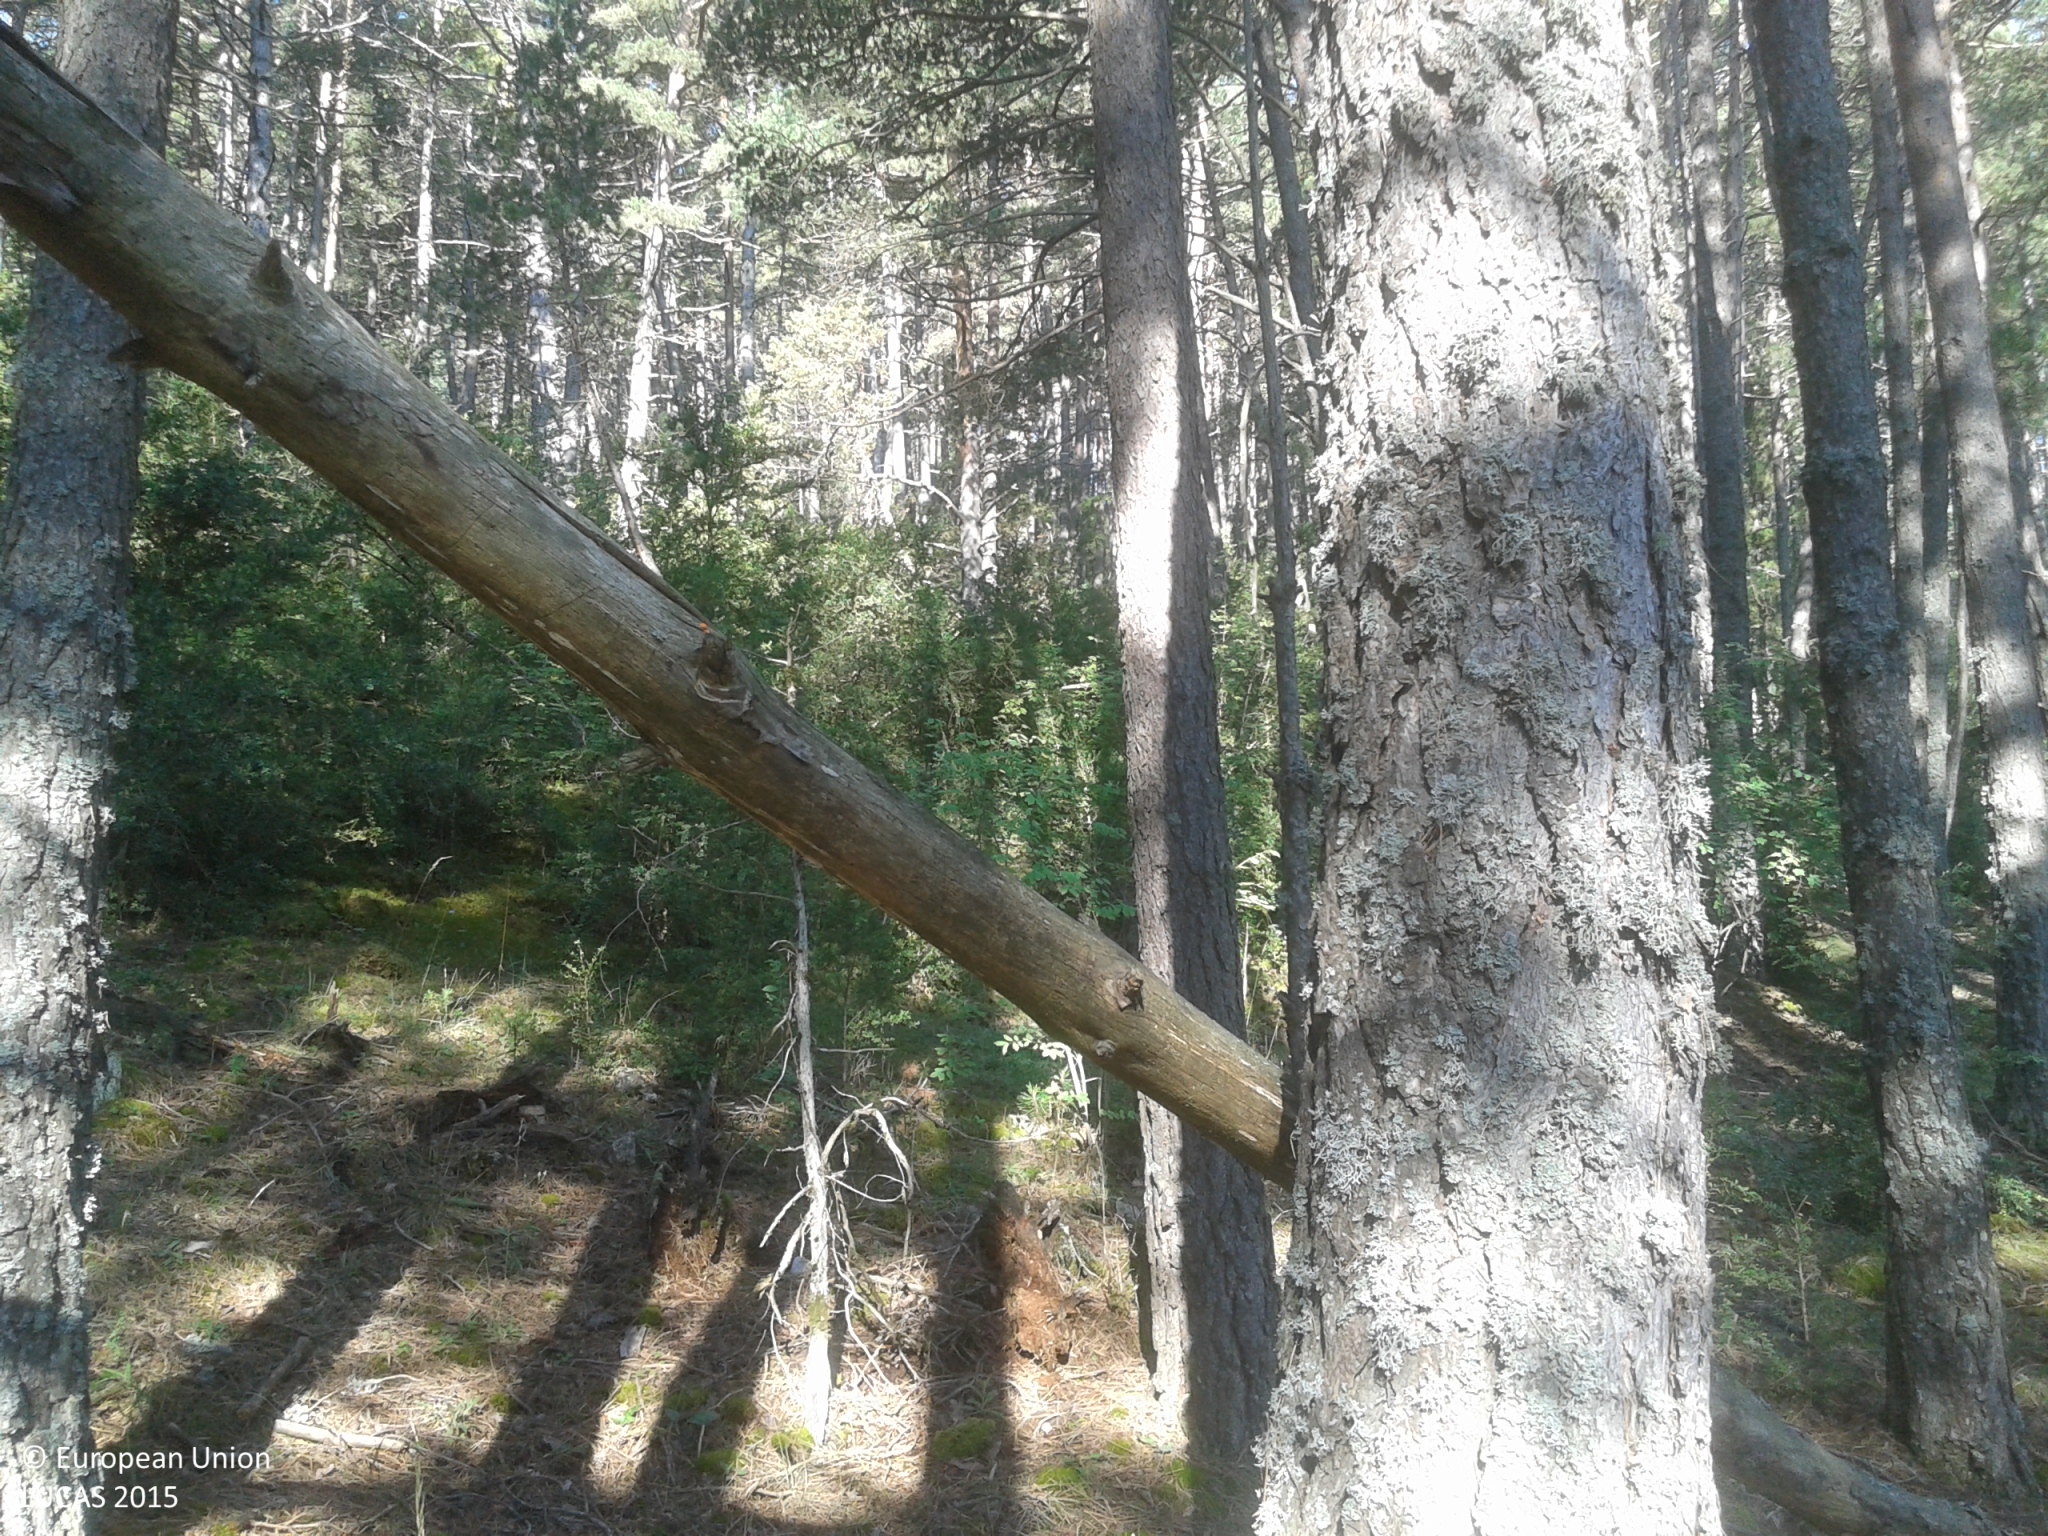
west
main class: Woodland
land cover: Pine dominated coniferous woodland
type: alpine coniferous forest
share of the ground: > 75 %
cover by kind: coniferous forest trees 95 %, shrubs 5 %
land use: Forestry
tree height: > 5 m
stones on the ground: 25 - 50 %
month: July
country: ES
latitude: 42.2271
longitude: 1.5421
